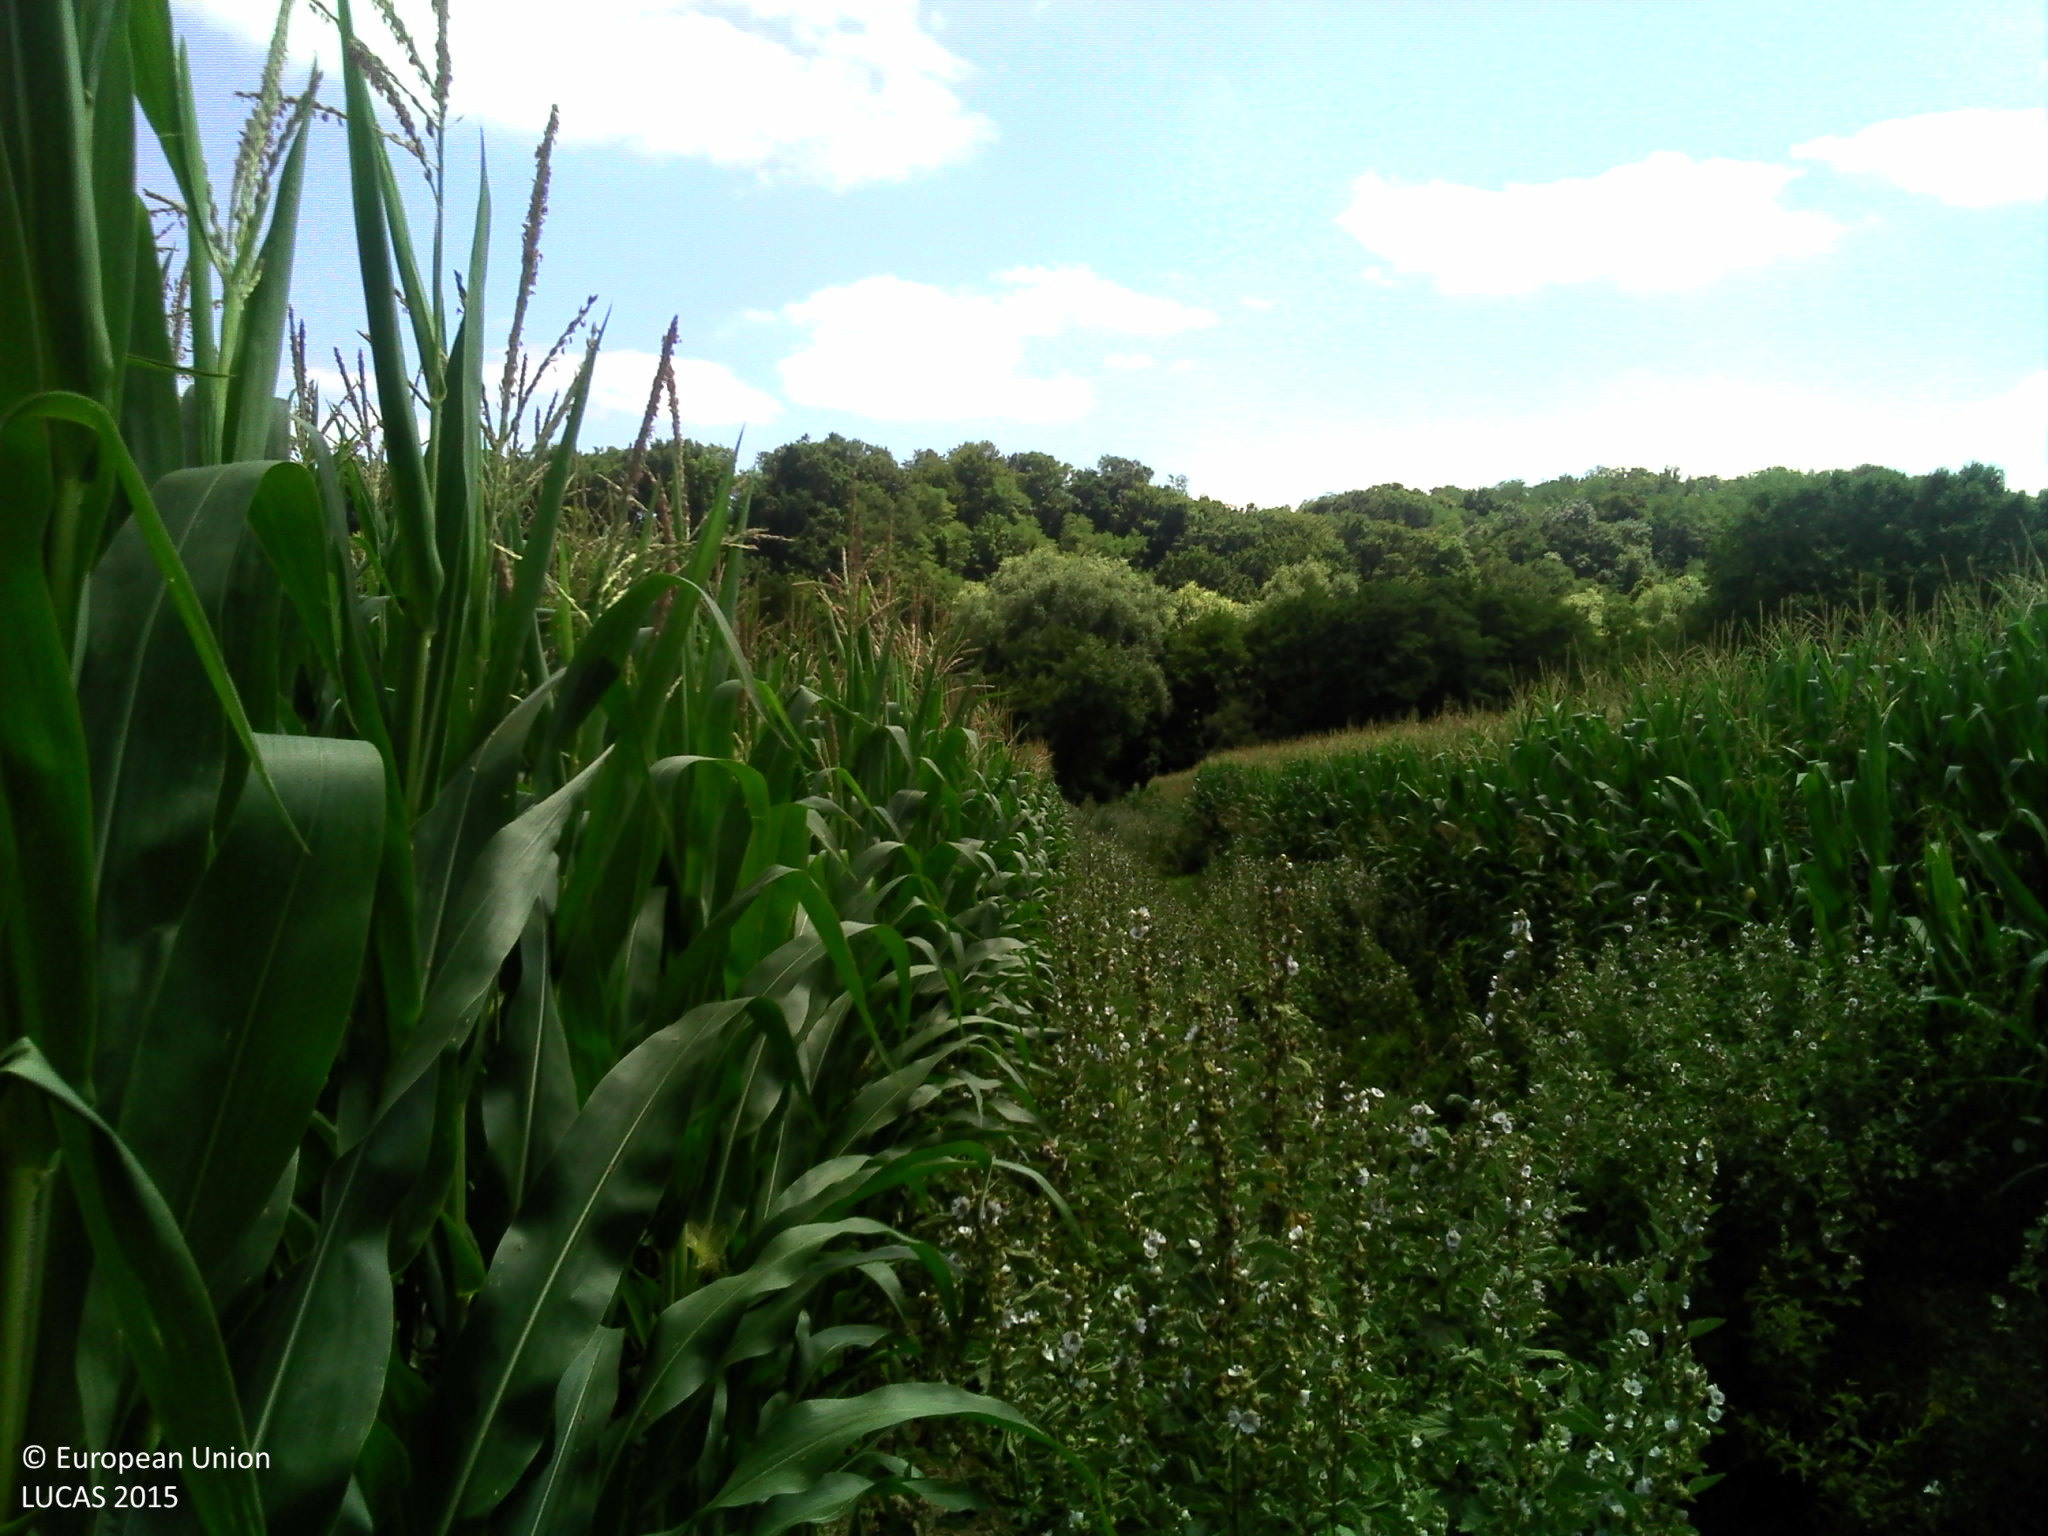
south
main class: Cropland
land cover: Maize
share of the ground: > 75 %
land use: Agriculture (excluding fallow land and kitchen gardens)
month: July
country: FR
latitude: 43.5332
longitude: -1.1147
